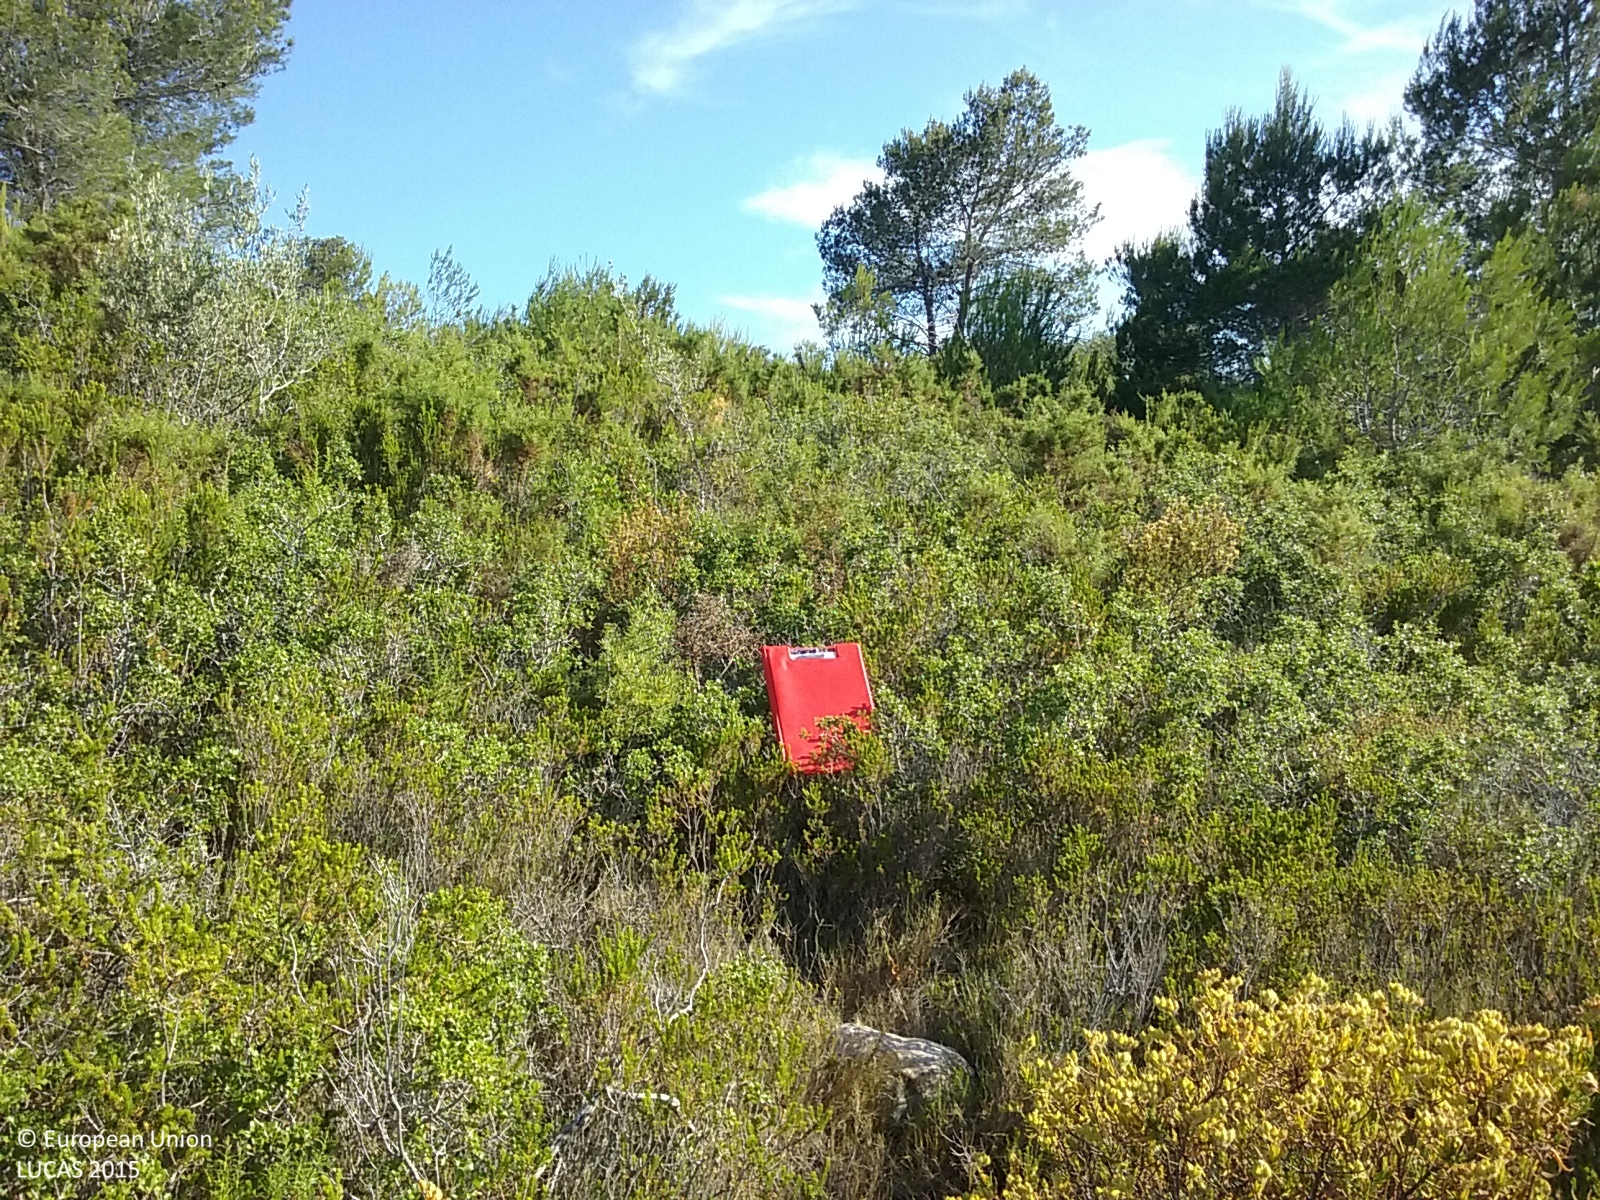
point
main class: Shrubland
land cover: Shrubland with sparse tree cover
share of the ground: > 75 %
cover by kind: shrubs 90 %, coniferous forest trees 5 %, herbaceous plants 5 %
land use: Semi-natural and natural areas not in use
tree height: < 5 m
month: June
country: ES
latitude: 40.1864
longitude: 0.1200
